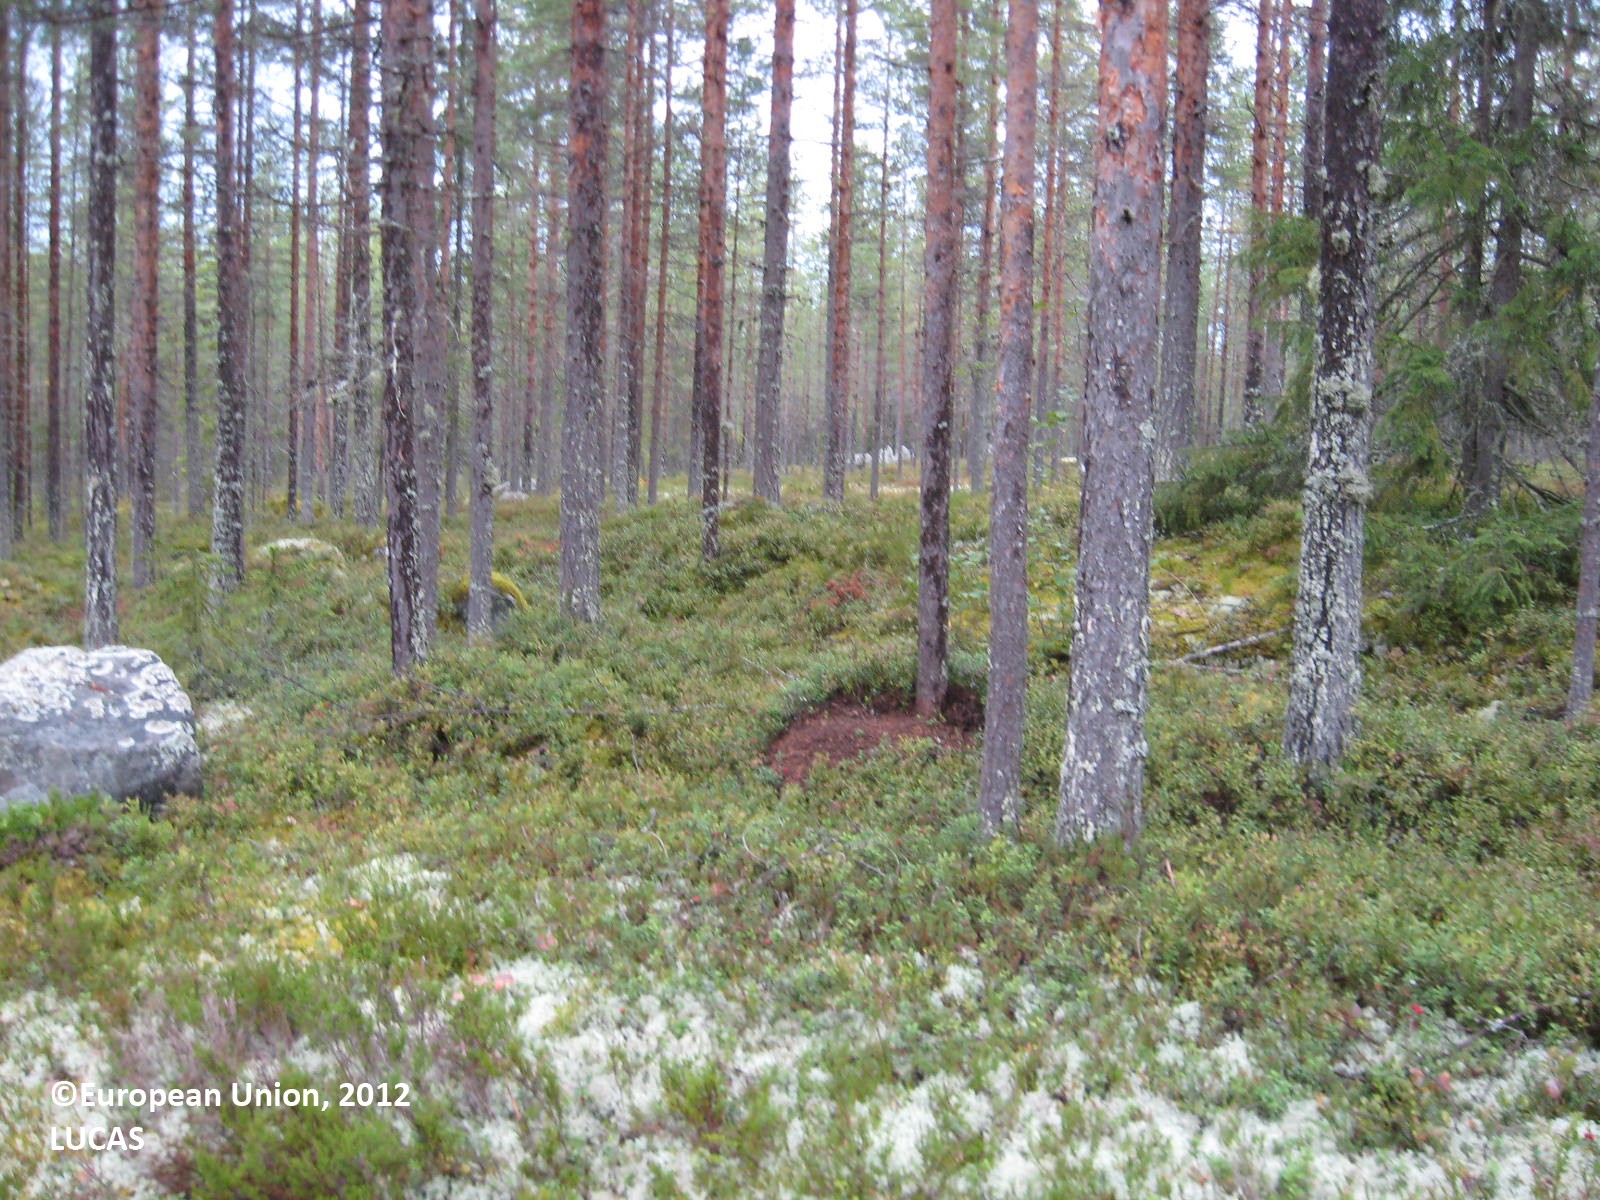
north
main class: Woodland
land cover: Pine dominated coniferous woodland
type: boreal forest
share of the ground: > 75 %
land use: Forestry
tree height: > 5 m
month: August
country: FI
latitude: 63.4859
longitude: 29.3559
